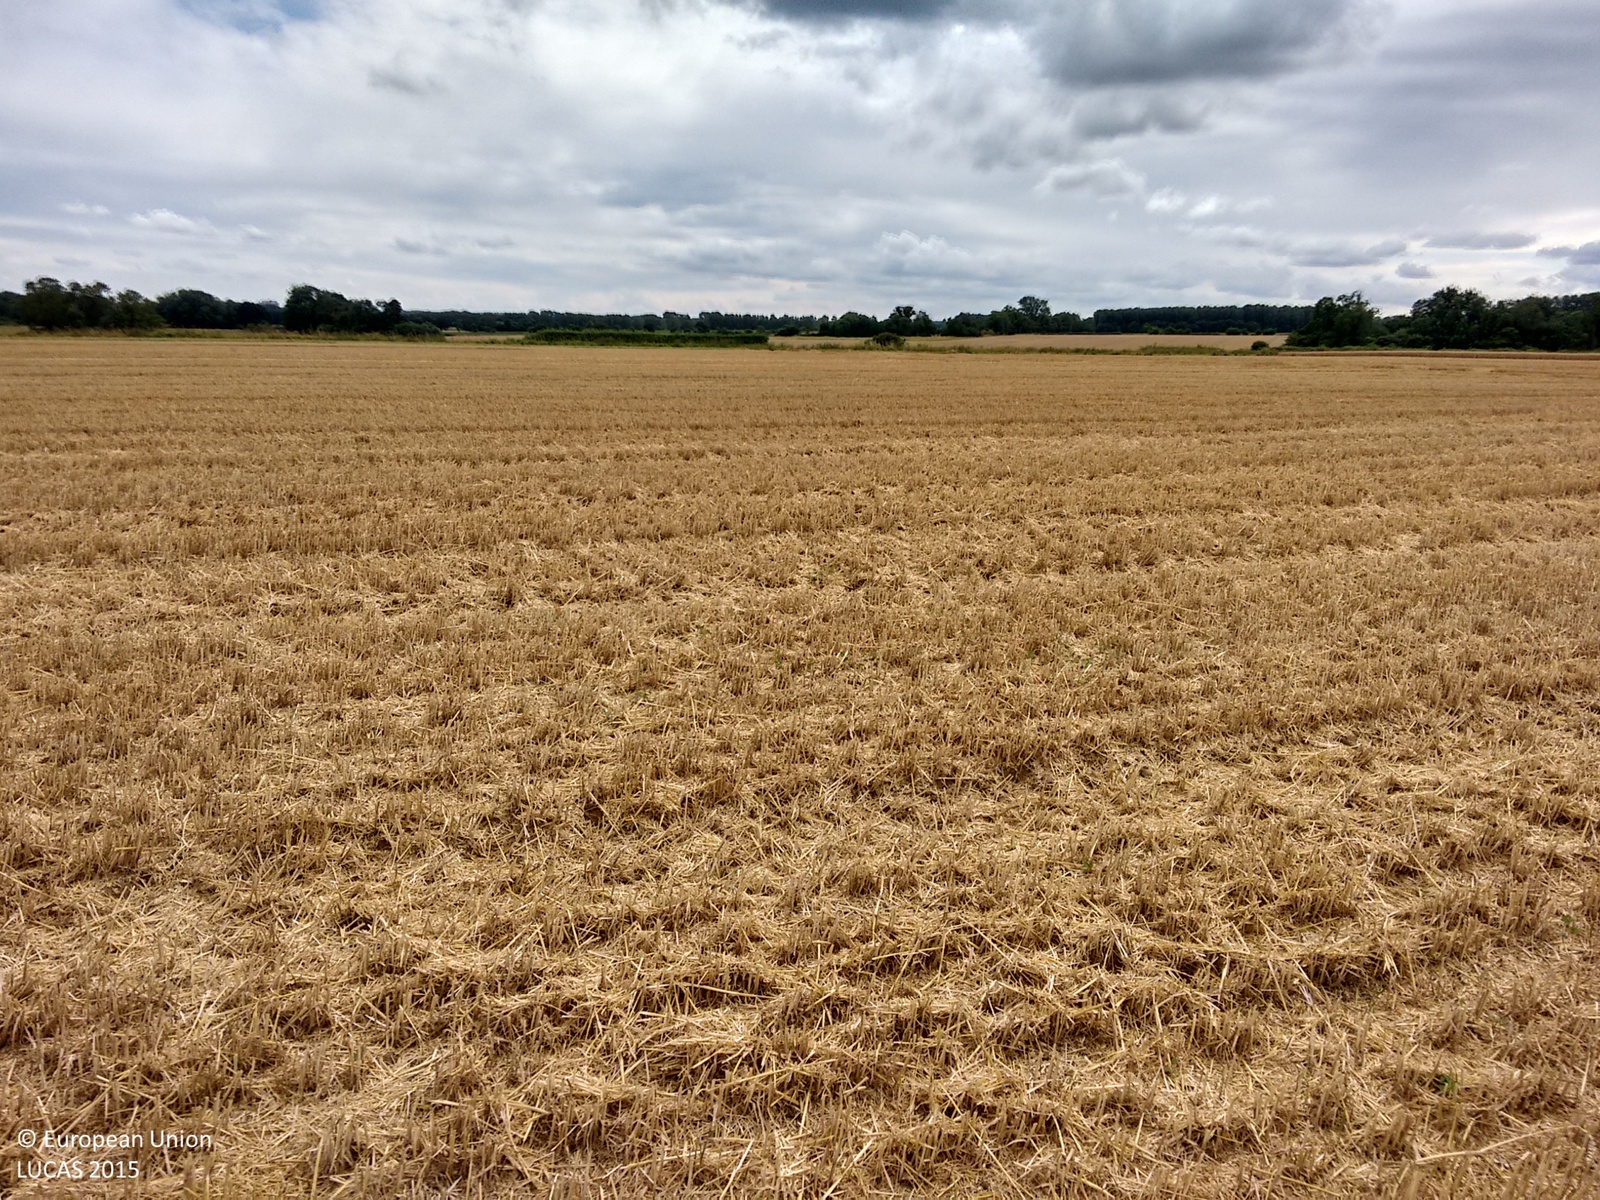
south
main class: Cropland
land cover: Common wheat
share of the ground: > 75 %
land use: Agriculture (excluding fallow land and kitchen gardens)
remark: Harvested field
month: August
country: GB
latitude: 52.6047
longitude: 0.4182
